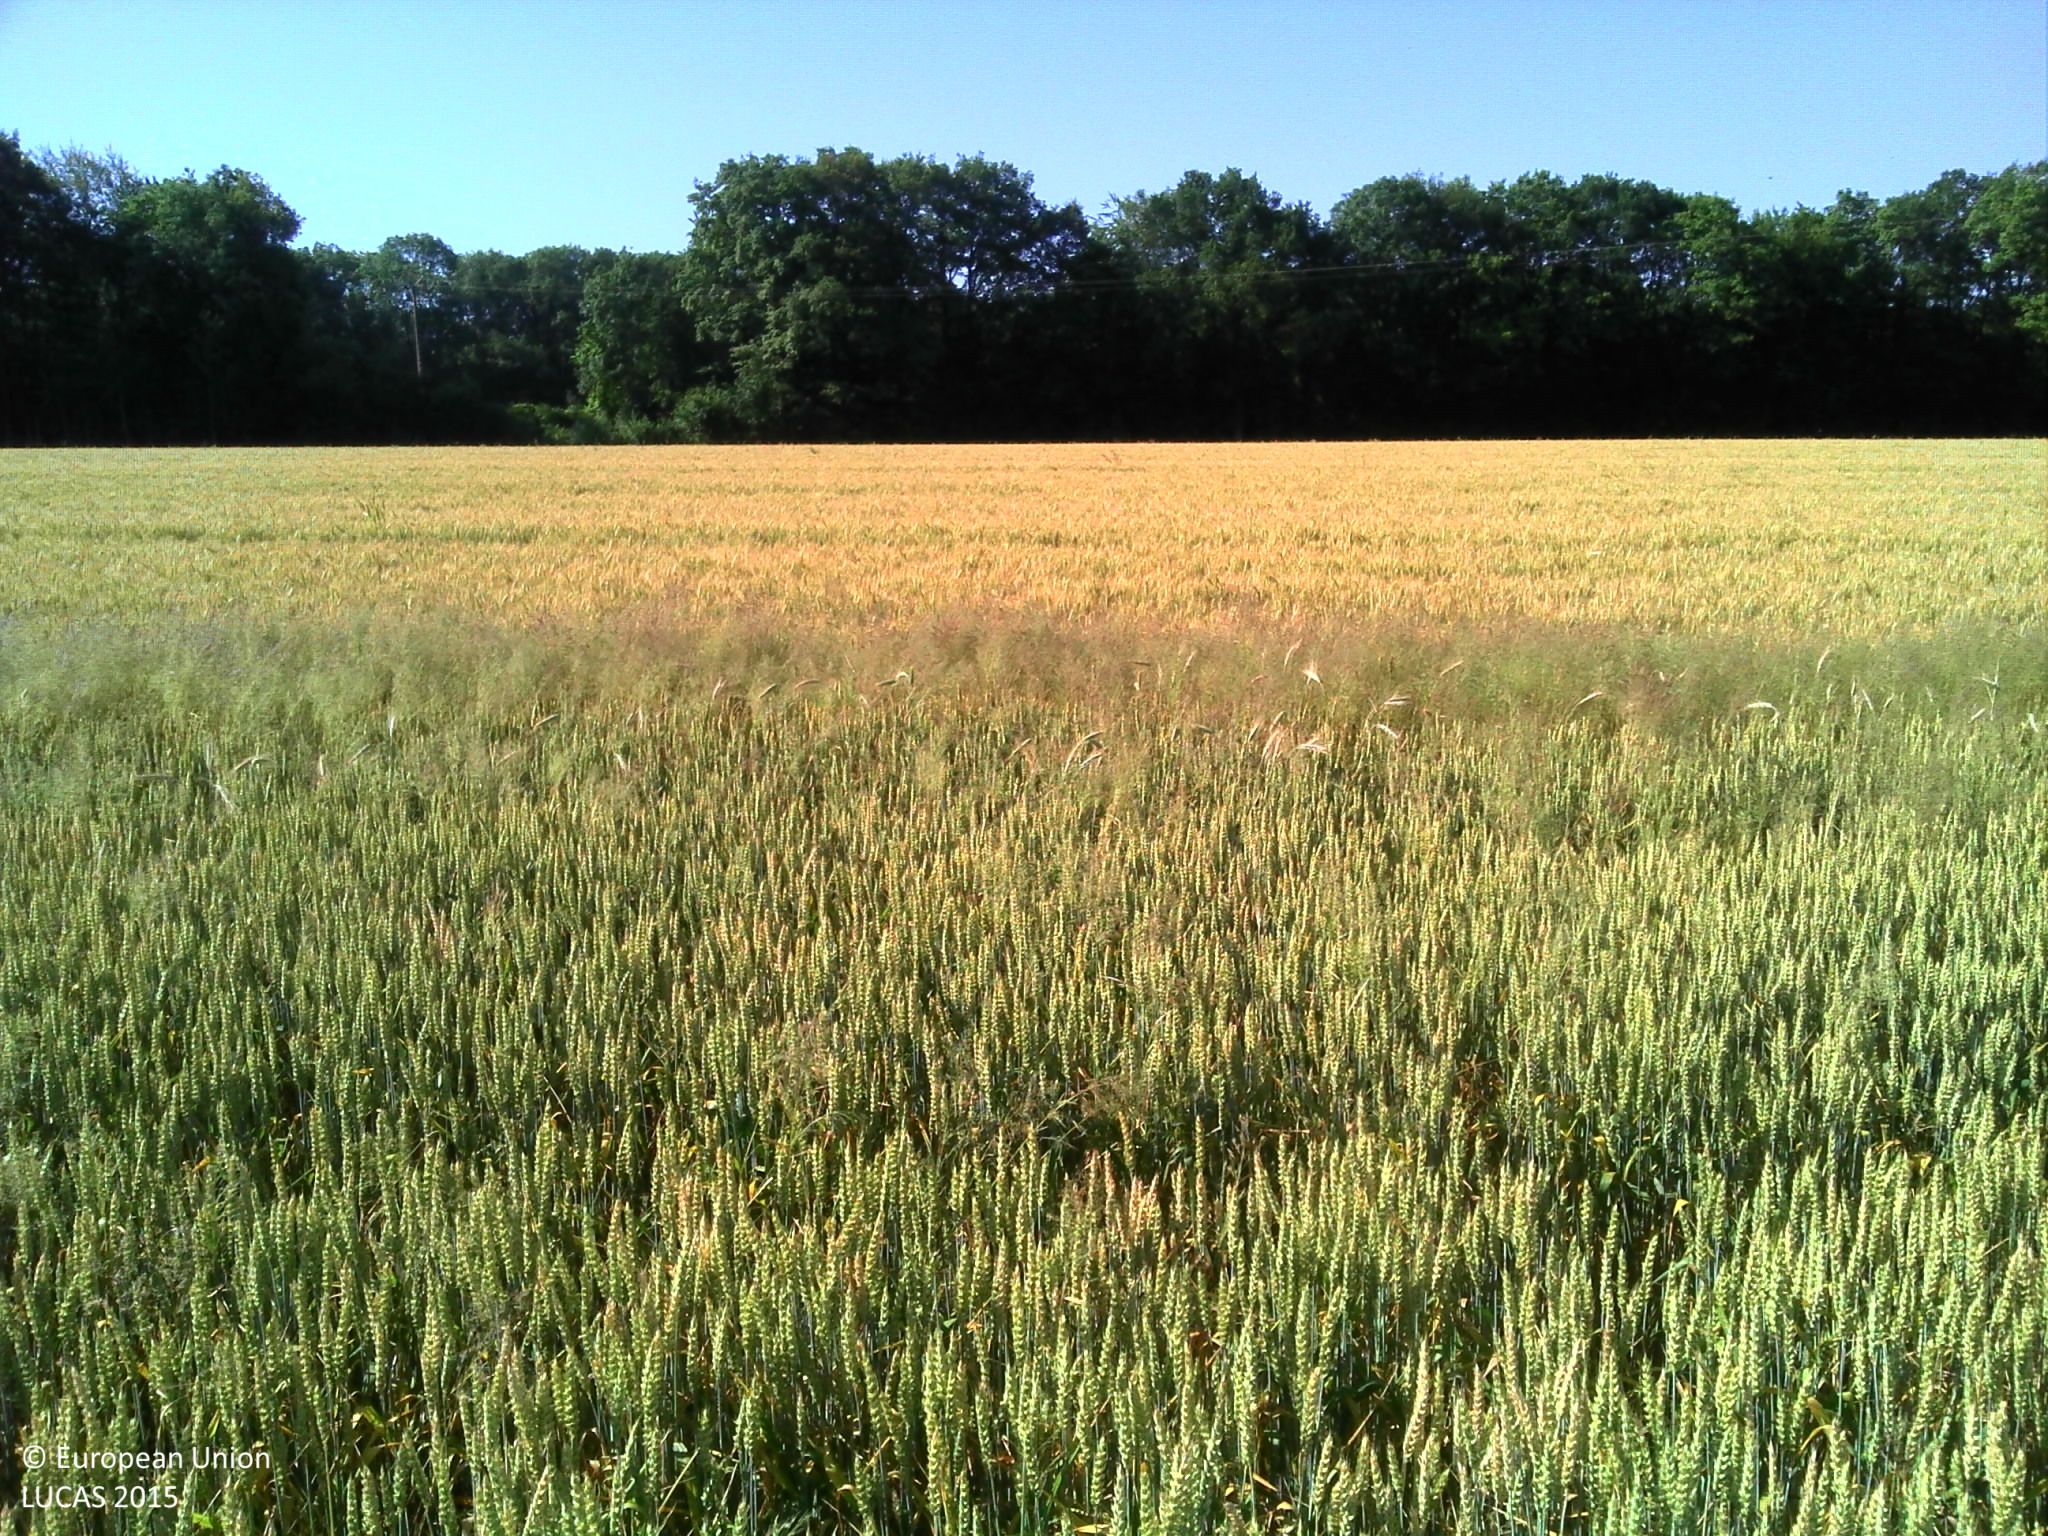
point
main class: Cropland
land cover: Common wheat
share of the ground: > 75 %
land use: Agriculture (excluding fallow land and kitchen gardens)
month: July
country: FR
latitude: 48.5739
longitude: 6.2459
